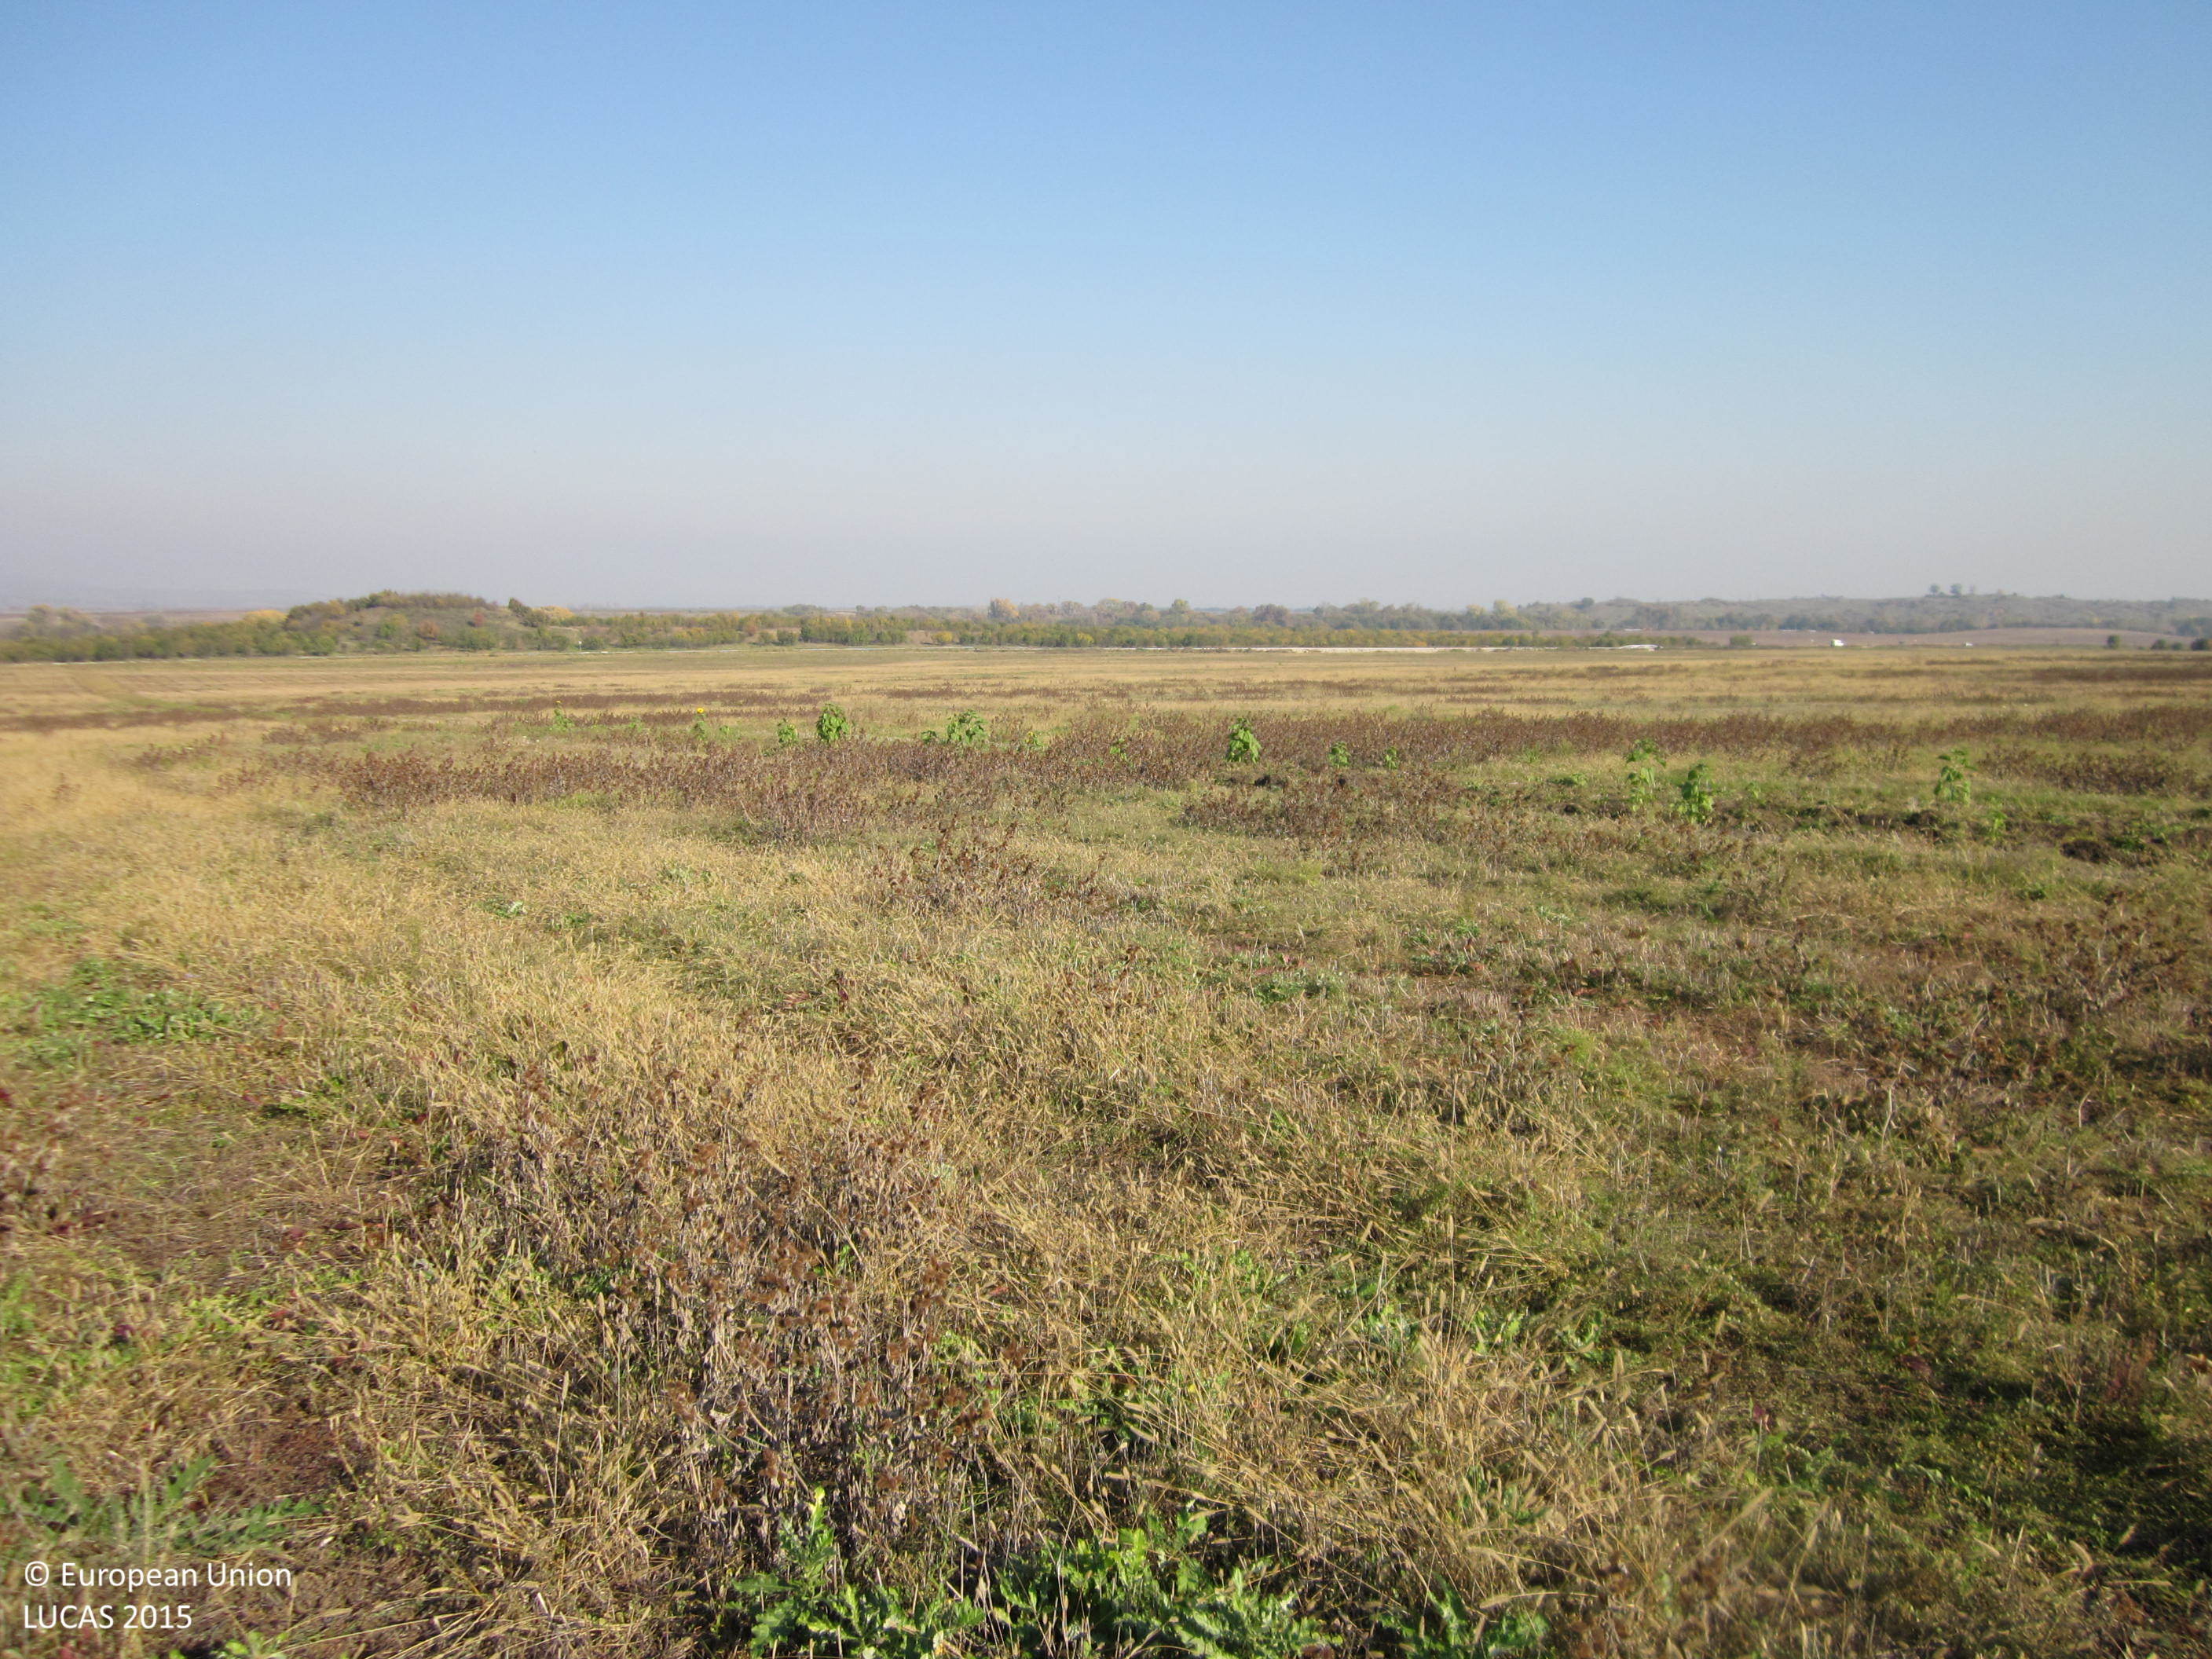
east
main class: Grassland
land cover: Spontaneously vegetated surfaces
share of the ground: > 75 %
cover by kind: herbaceous plants 100 %
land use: Fallow land
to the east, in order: Spontaneously vegetated surfaces
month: November
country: BG
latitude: 42.4039
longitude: 24.6694
